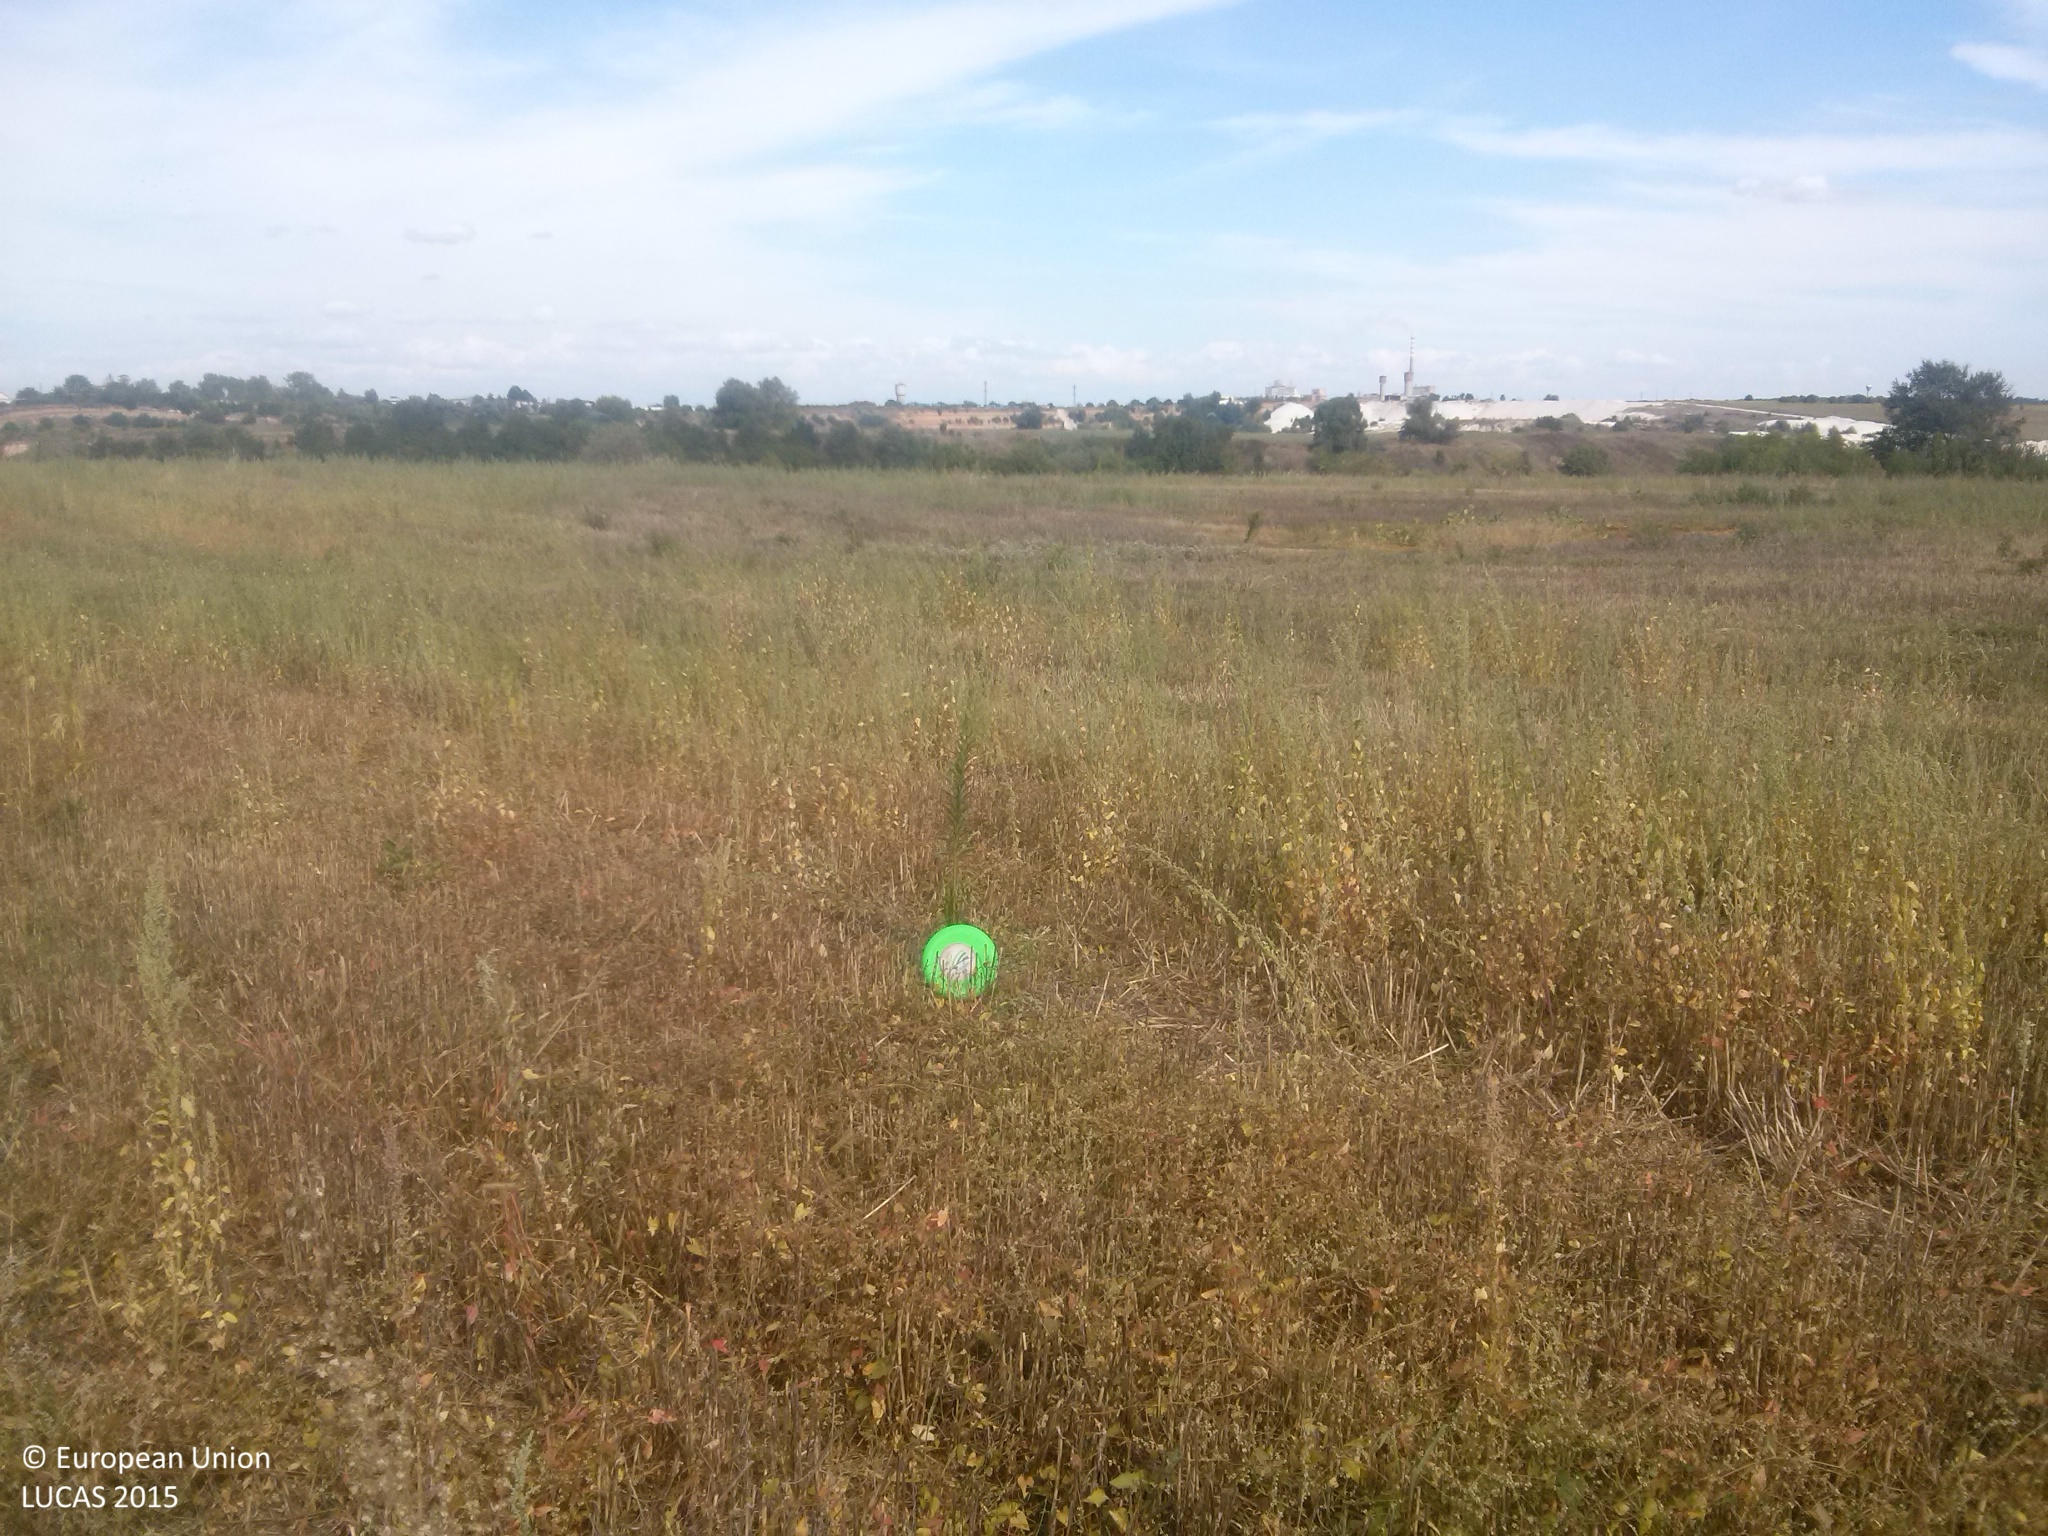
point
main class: Cropland
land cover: Common wheat
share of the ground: 25 - 50 %
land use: Agriculture (excluding fallow land and kitchen gardens)
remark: Harvested field
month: September
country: BG
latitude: 43.6855
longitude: 26.2400
